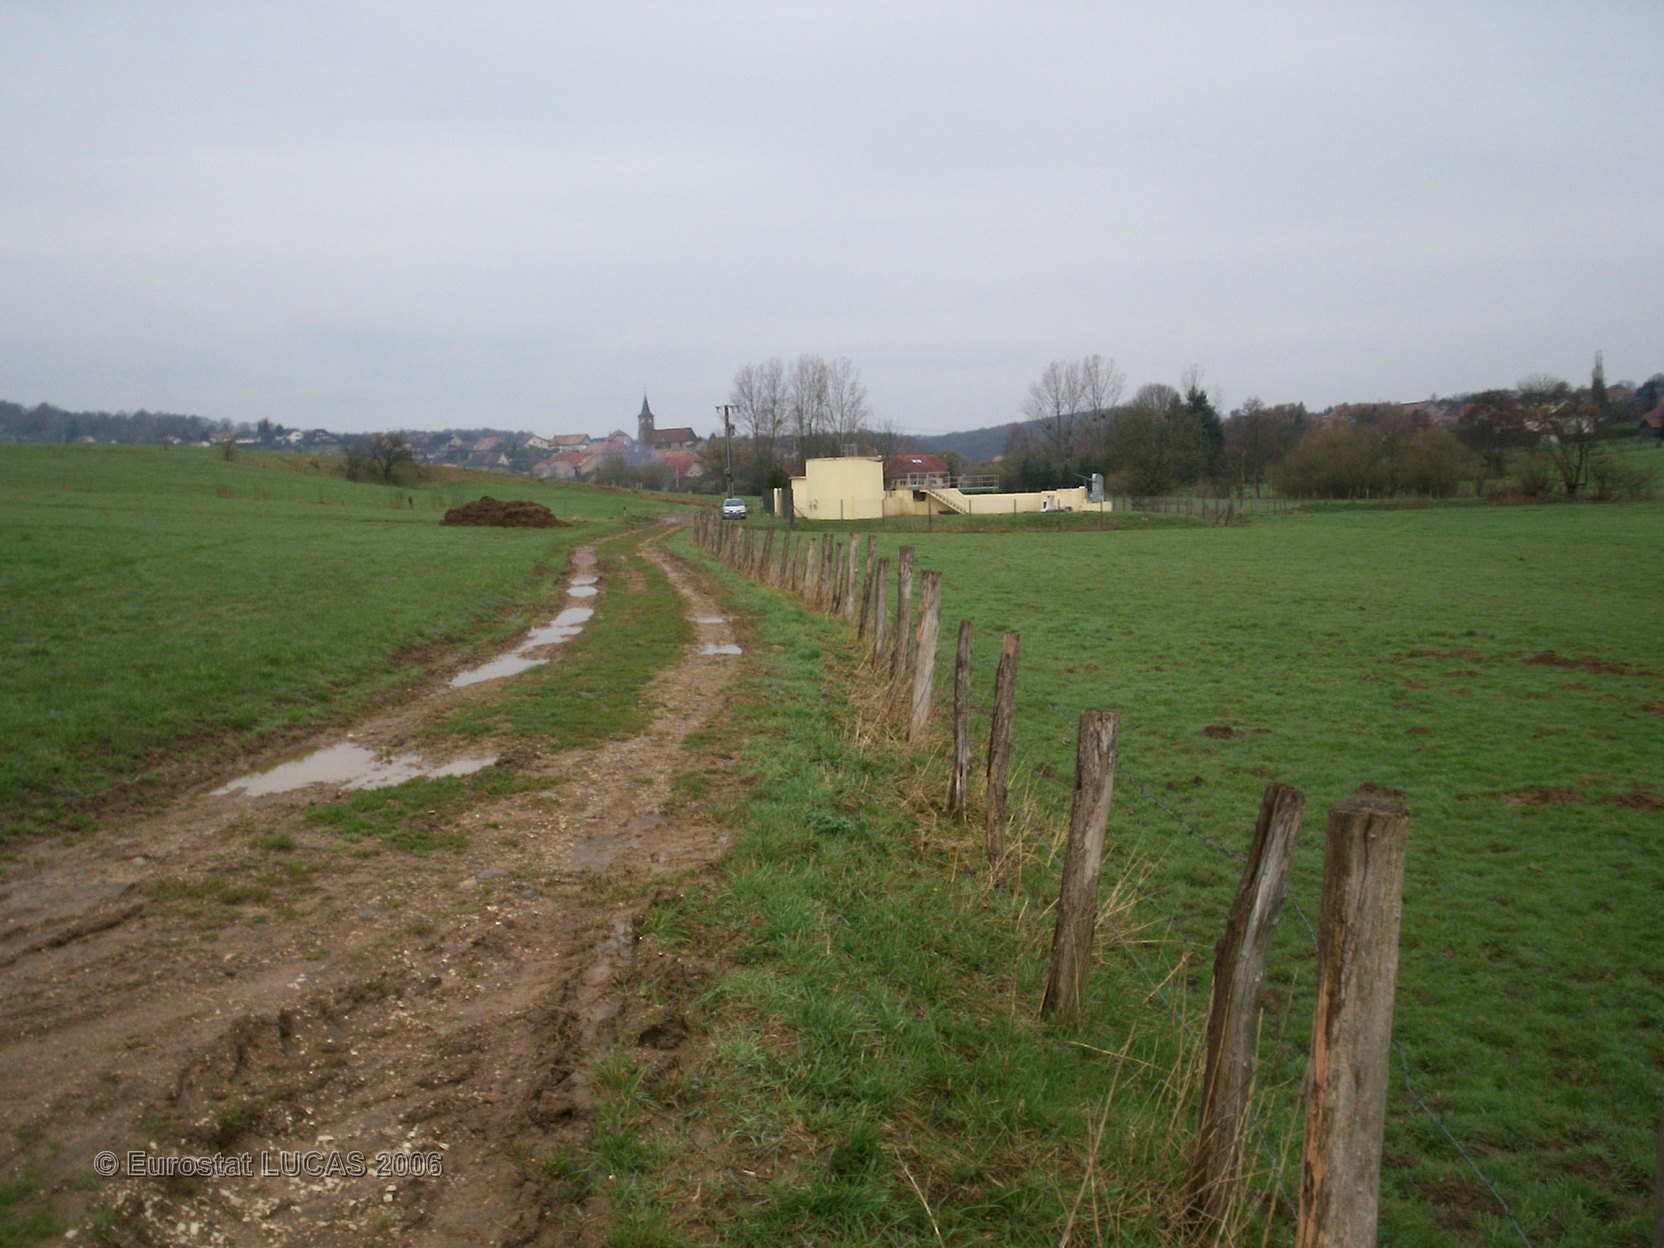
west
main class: Grassland
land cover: Grassland without tree/shrub cover
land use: Agriculture (excluding fallow land and kitchen gardens)
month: April
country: FR
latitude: 47.6366
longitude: 6.7939
